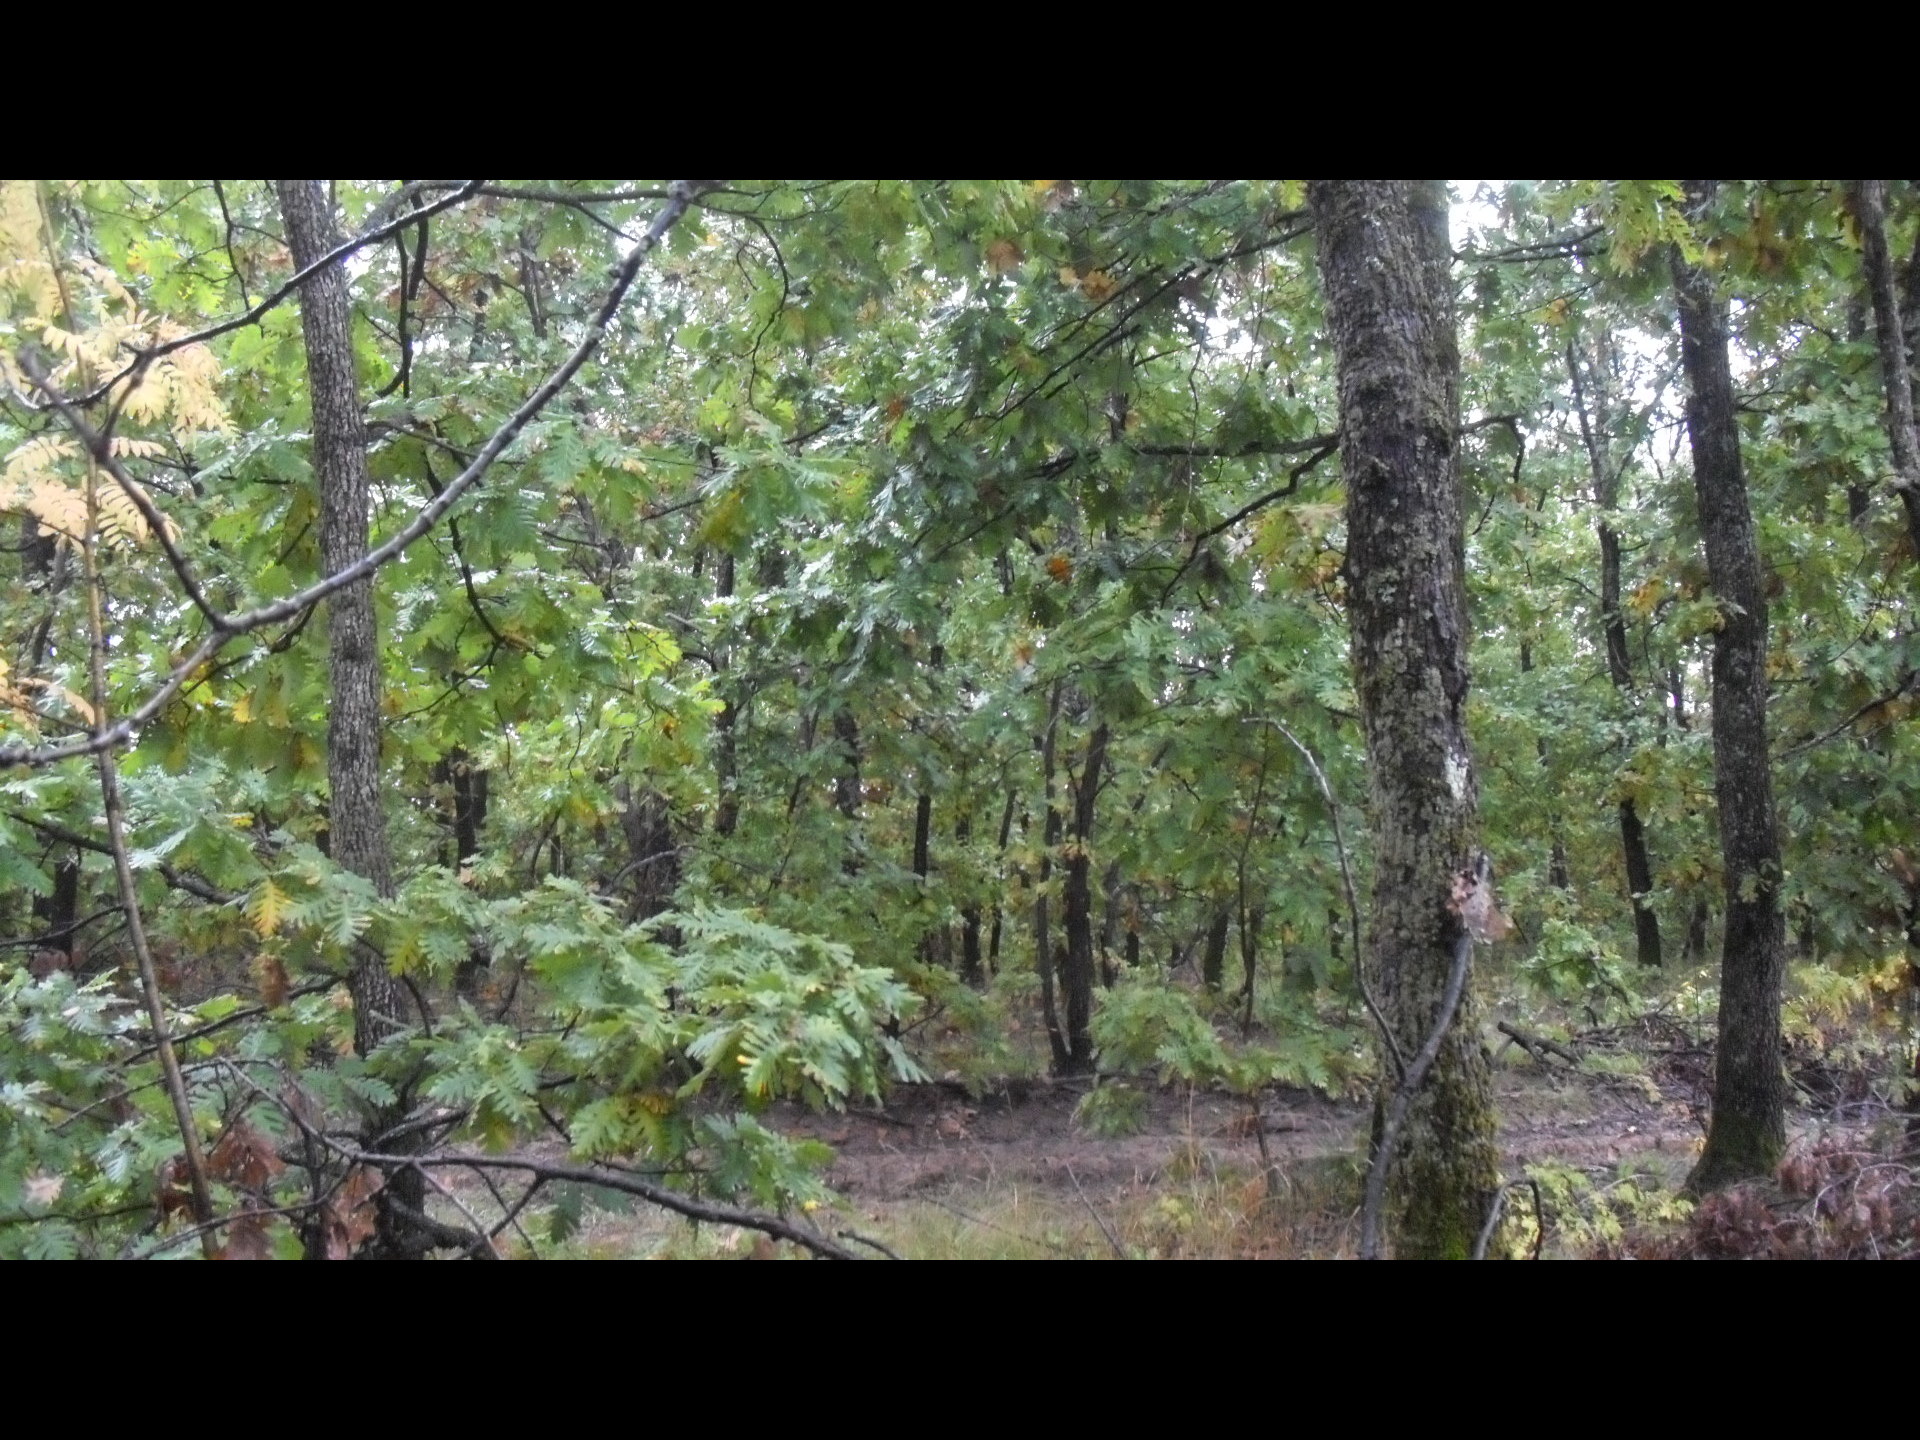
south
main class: Woodland
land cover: Broadleaved woodland
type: mesophytic deciduous forest
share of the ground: > 75 %
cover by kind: broadleaved forest trees 80 %, herbaceous plants 20 %
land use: Forestry
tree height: > 5 m
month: October
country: BG
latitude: 43.7062
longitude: 22.6046
